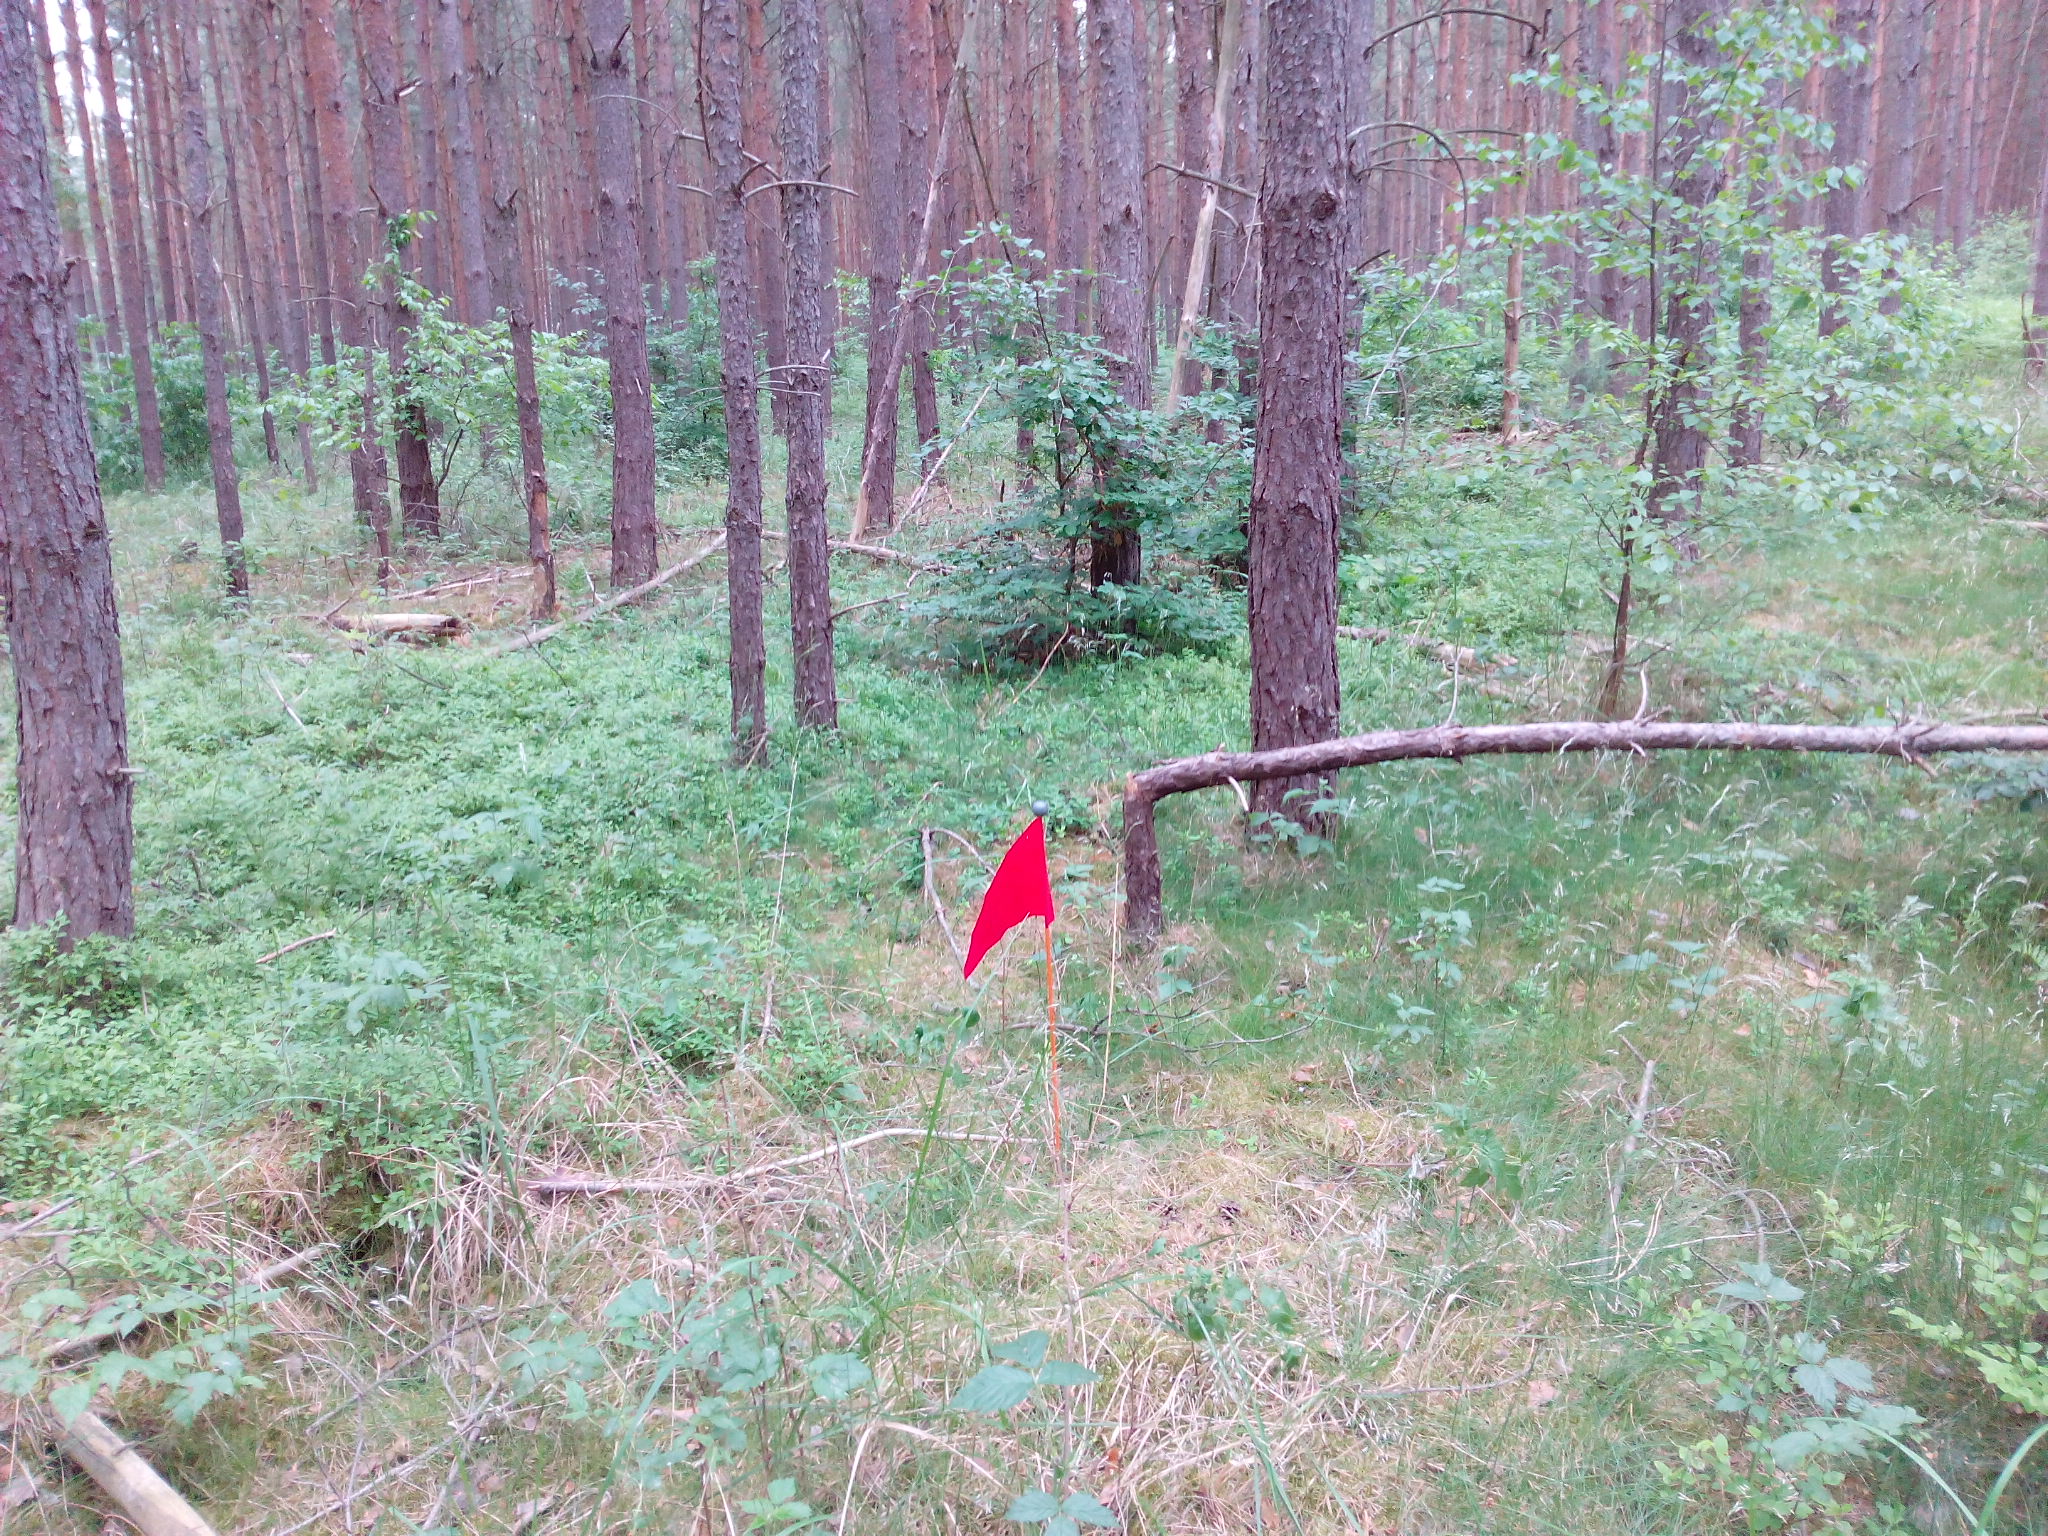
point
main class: Woodland
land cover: Pine dominated coniferous woodland
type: hemiboreal forest and nemoral coniferous forest and mixed broadleaved-coniferous forest
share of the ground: 50 - 75 %
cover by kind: coniferous forest trees 60 %, herbaceous plants 15 %, lichens and mosses 15 %, shrubs 10 %
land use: Forestry
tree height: > 5 m
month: June
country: DE
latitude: 53.0078
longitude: 13.5620
